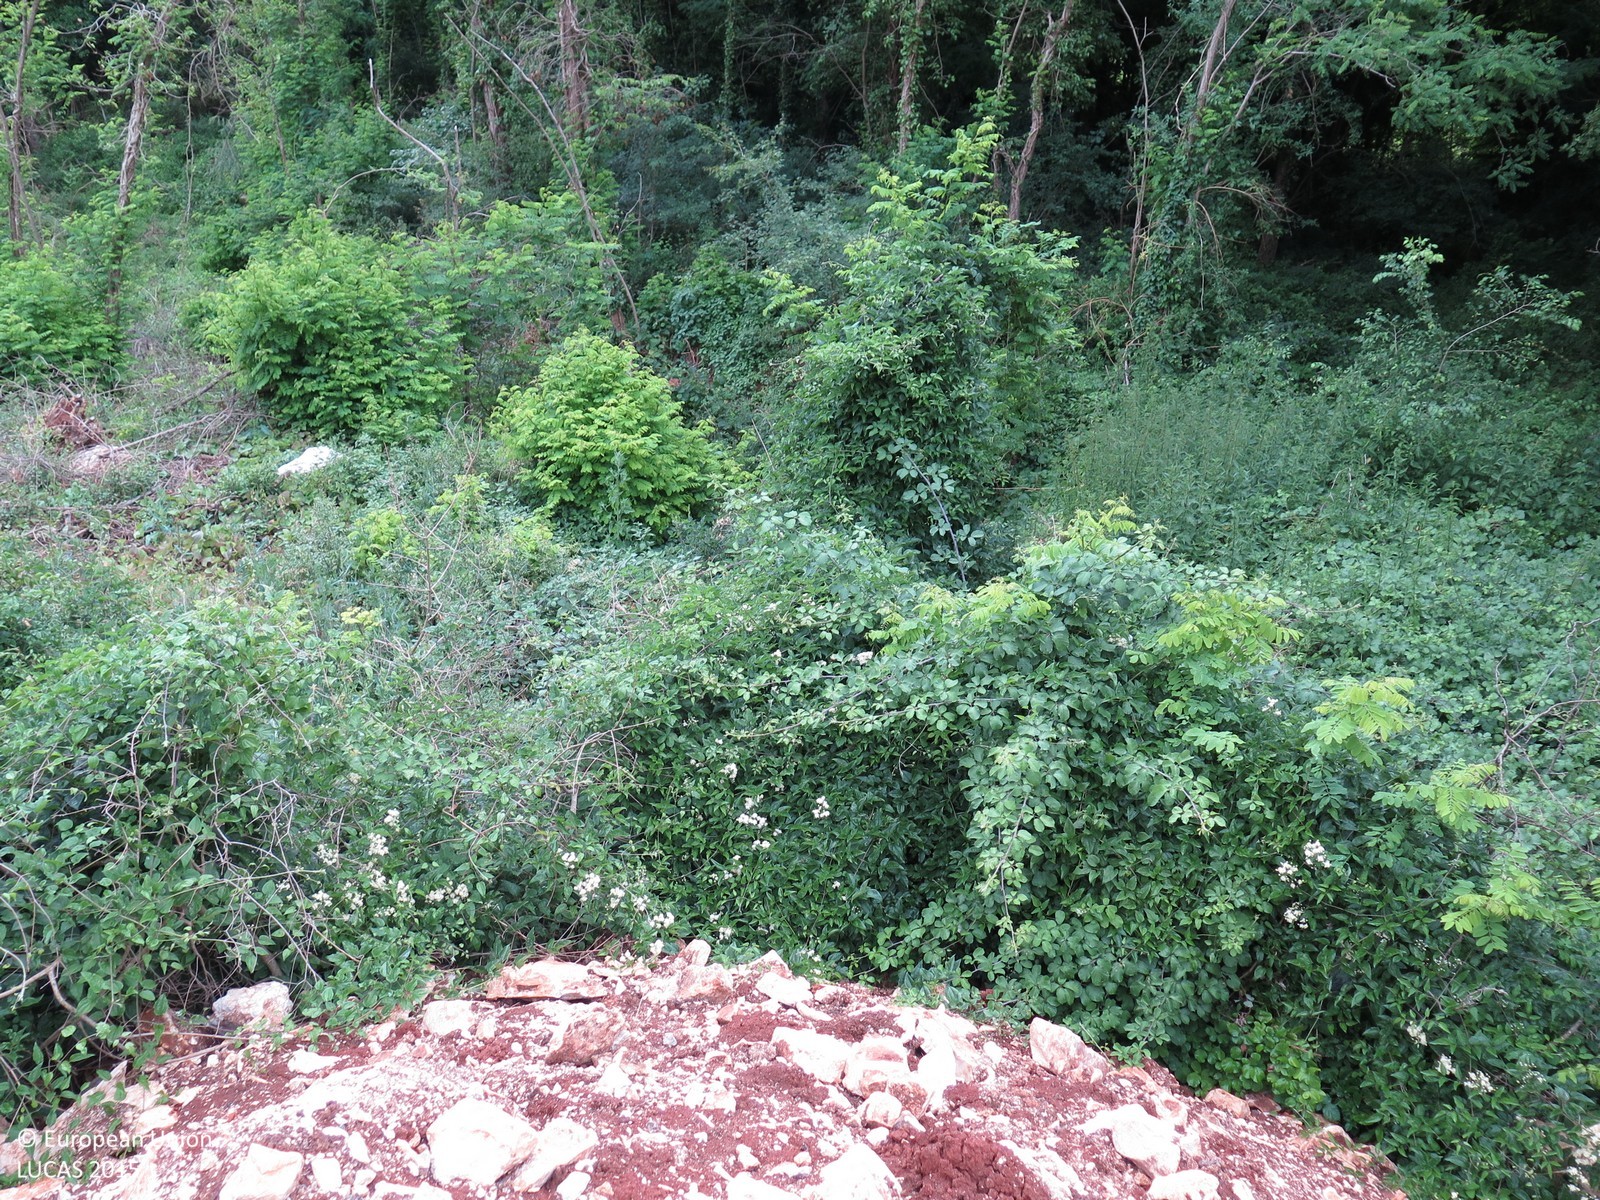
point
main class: Shrubland
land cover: Shrubland with sparse tree cover
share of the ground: > 75 %
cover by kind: shrubs 95 %, broadleaved forest trees 5 %
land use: Abandoned areas
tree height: < 5 m
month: June
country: HR
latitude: 45.2077
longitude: 13.6235
